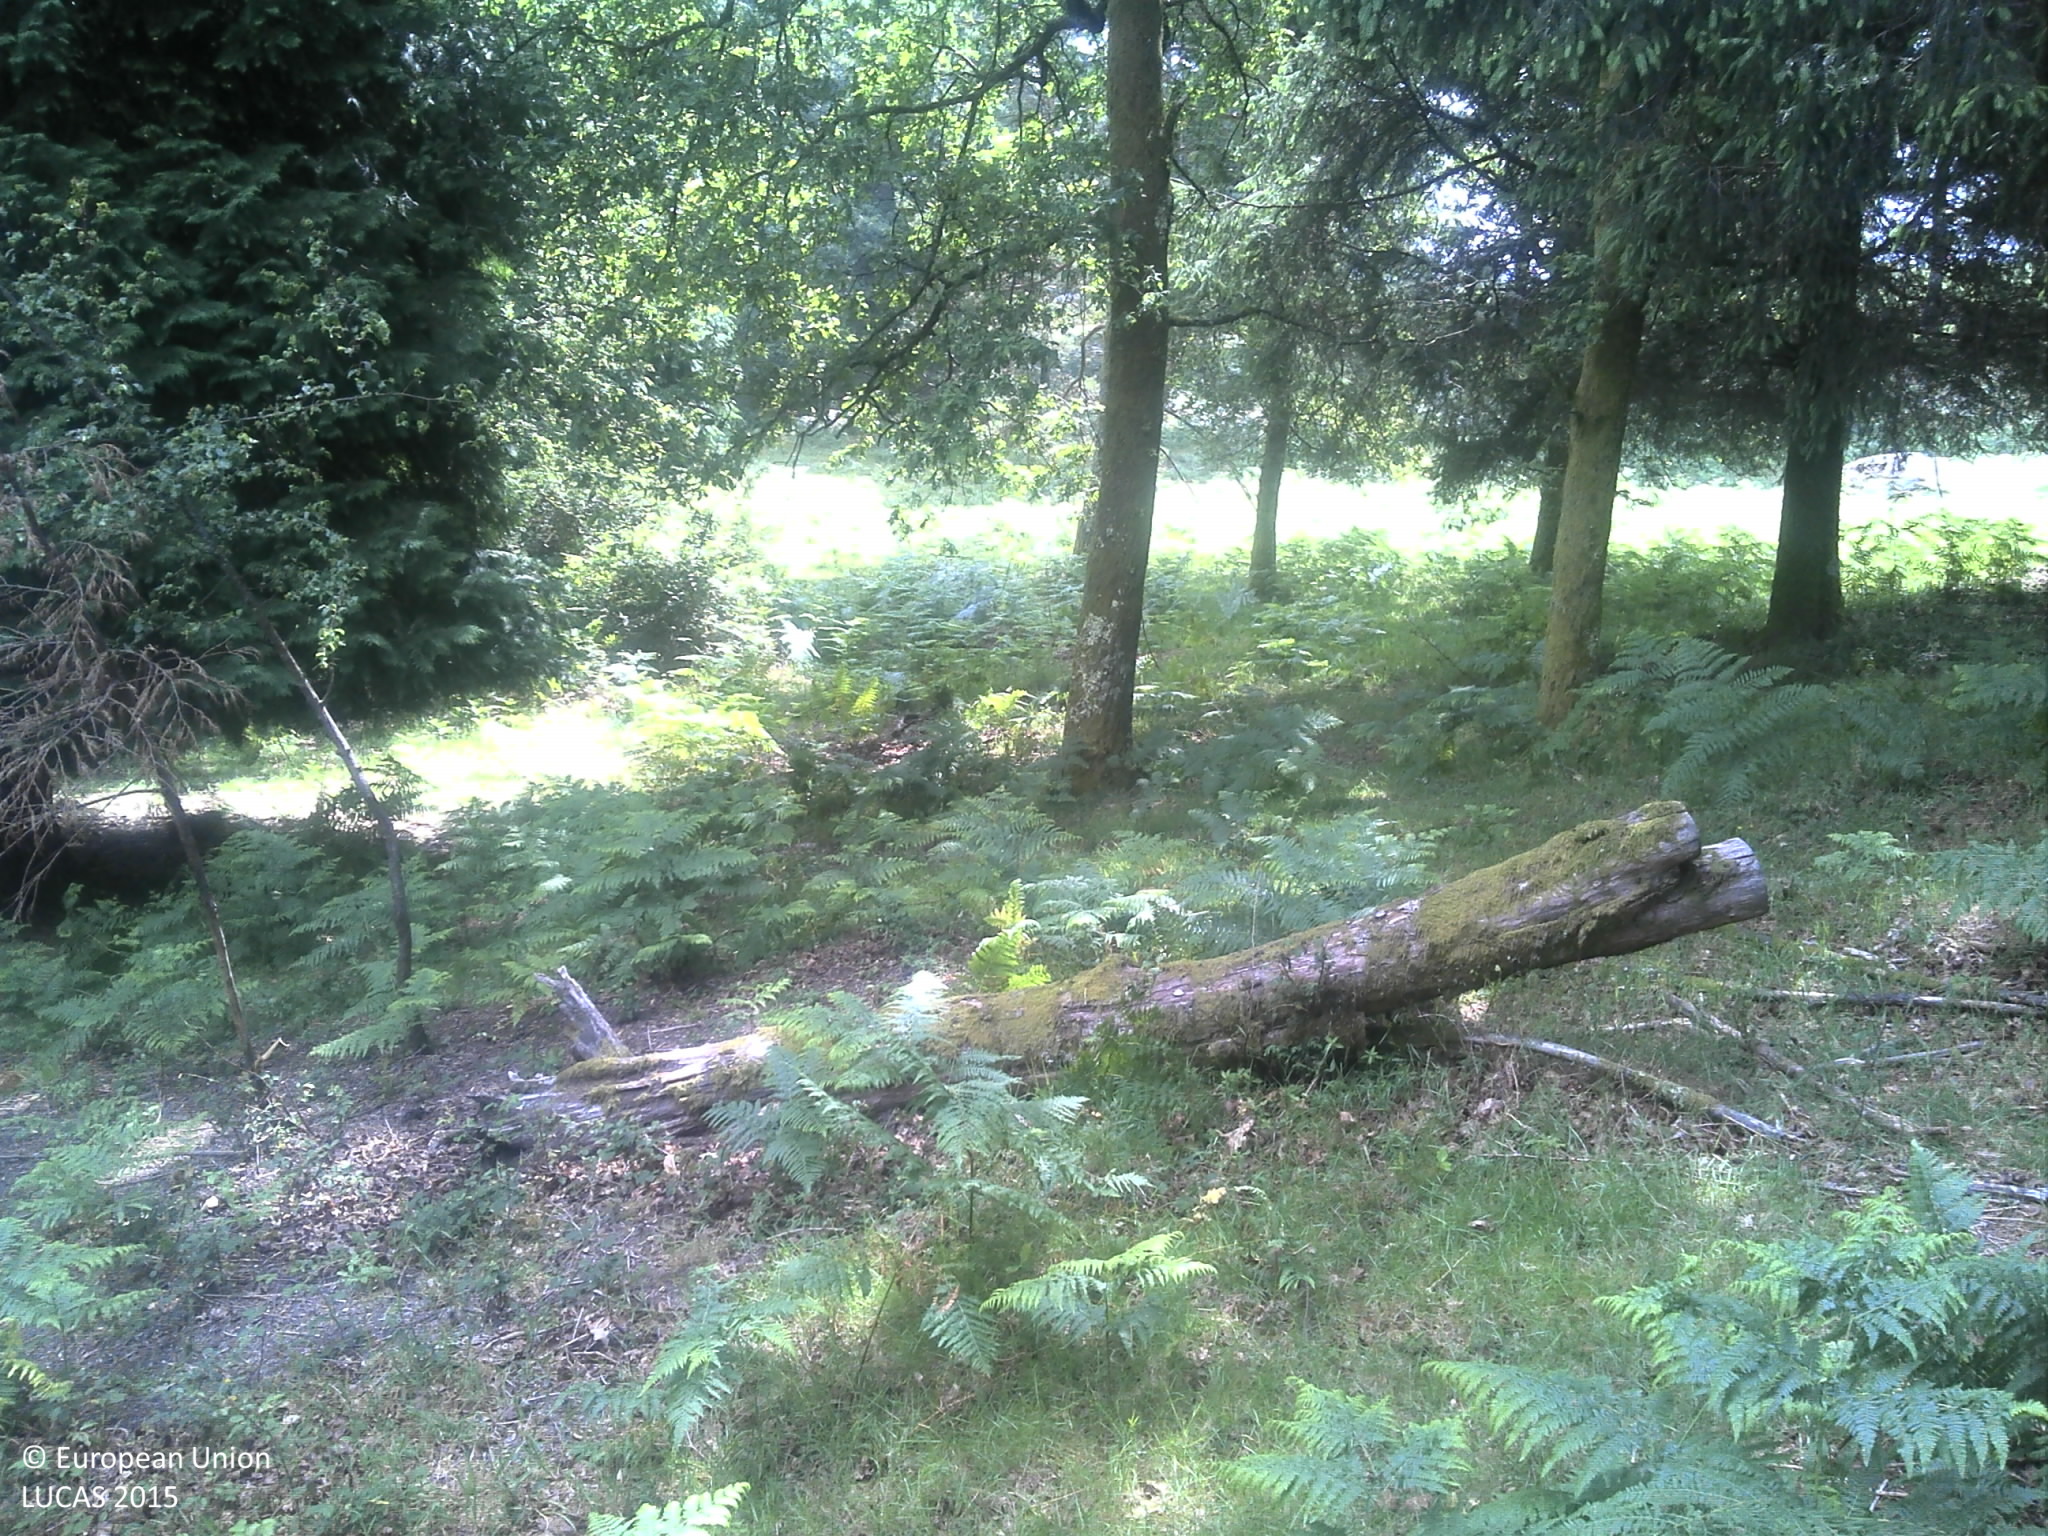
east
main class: Woodland
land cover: Other mixed woodland
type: mesophytic deciduous forest
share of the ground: 50 - 75 %
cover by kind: coniferous forest trees 50 %, shrubs 25 %, broadleaved forest trees 20 %, herbaceous plants 5 %
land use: Agriculture (excluding fallow land and kitchen gardens)
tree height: > 5 m
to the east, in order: Other mixed woodland; Shrubland without tree cover; Other coniferous woodland; Grassland without tree/shrub cover; Electric lines; Grassland without tree/shrub cover; Other coniferous woodland; Tracks; Dry stone walls; Broadleaved woodland; Pine dominated mixed woodland; Broadleaved woodland; Arable land (only in case pi)
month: June
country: PT
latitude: 41.6934
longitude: -8.2831
